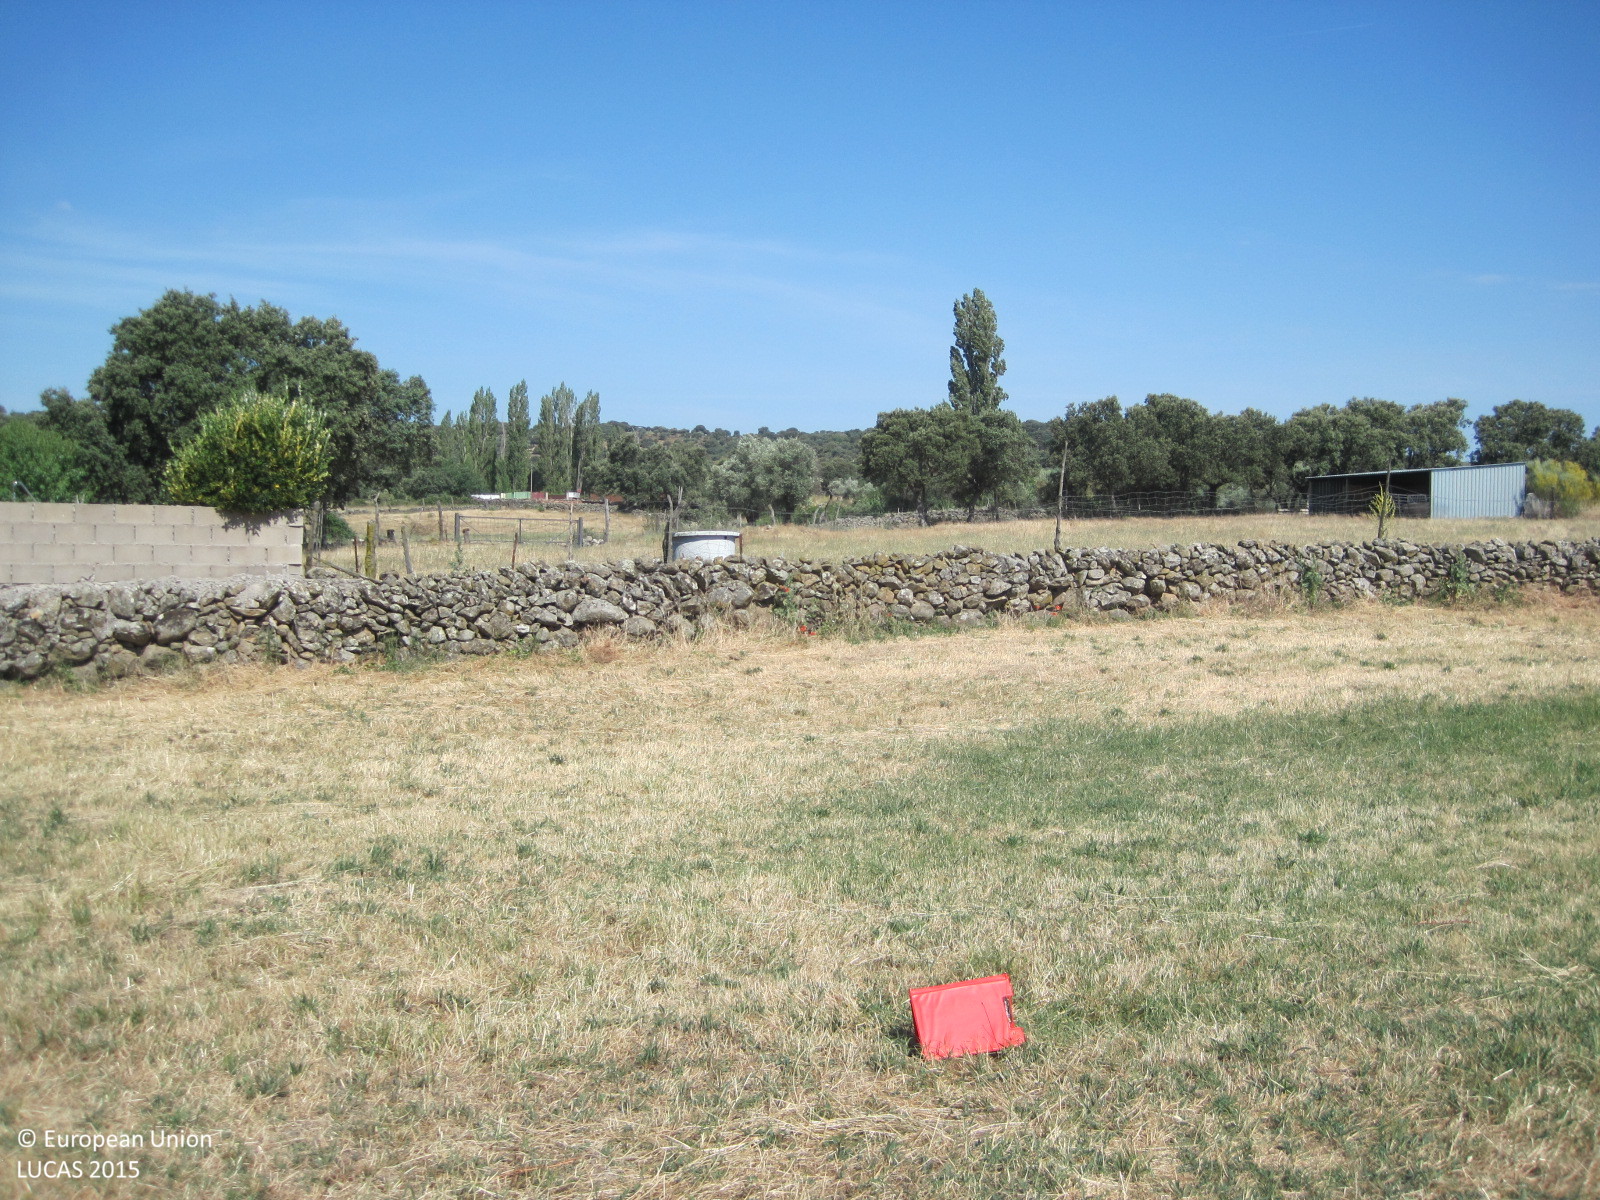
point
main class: Grassland
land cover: Grassland without tree/shrub cover
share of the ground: > 75 %
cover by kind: herbaceous plants 100 %
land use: Agriculture (excluding fallow land and kitchen gardens)
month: June
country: ES
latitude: 40.0547
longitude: -4.8076
